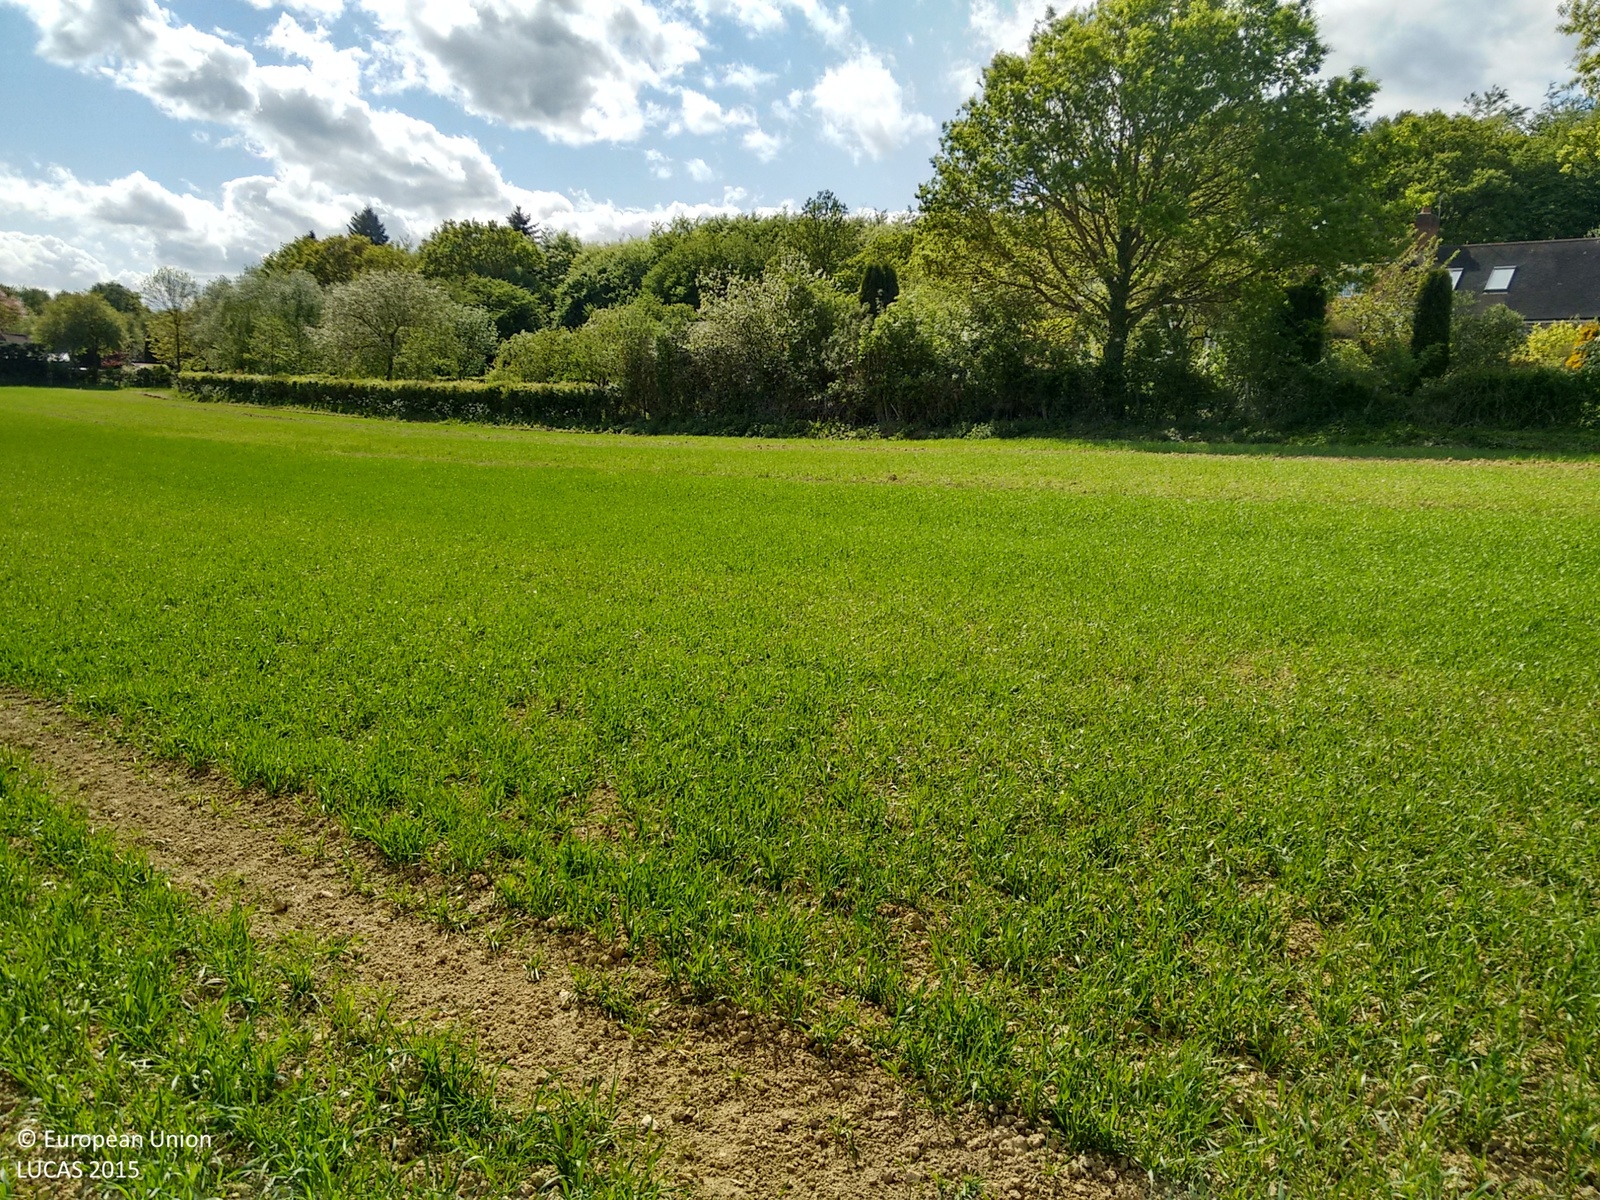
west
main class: Cropland
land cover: Common wheat
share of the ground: 25 - 50 %
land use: Agriculture (excluding fallow land and kitchen gardens)
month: May
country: GB
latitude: 51.2370
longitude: 0.3022
